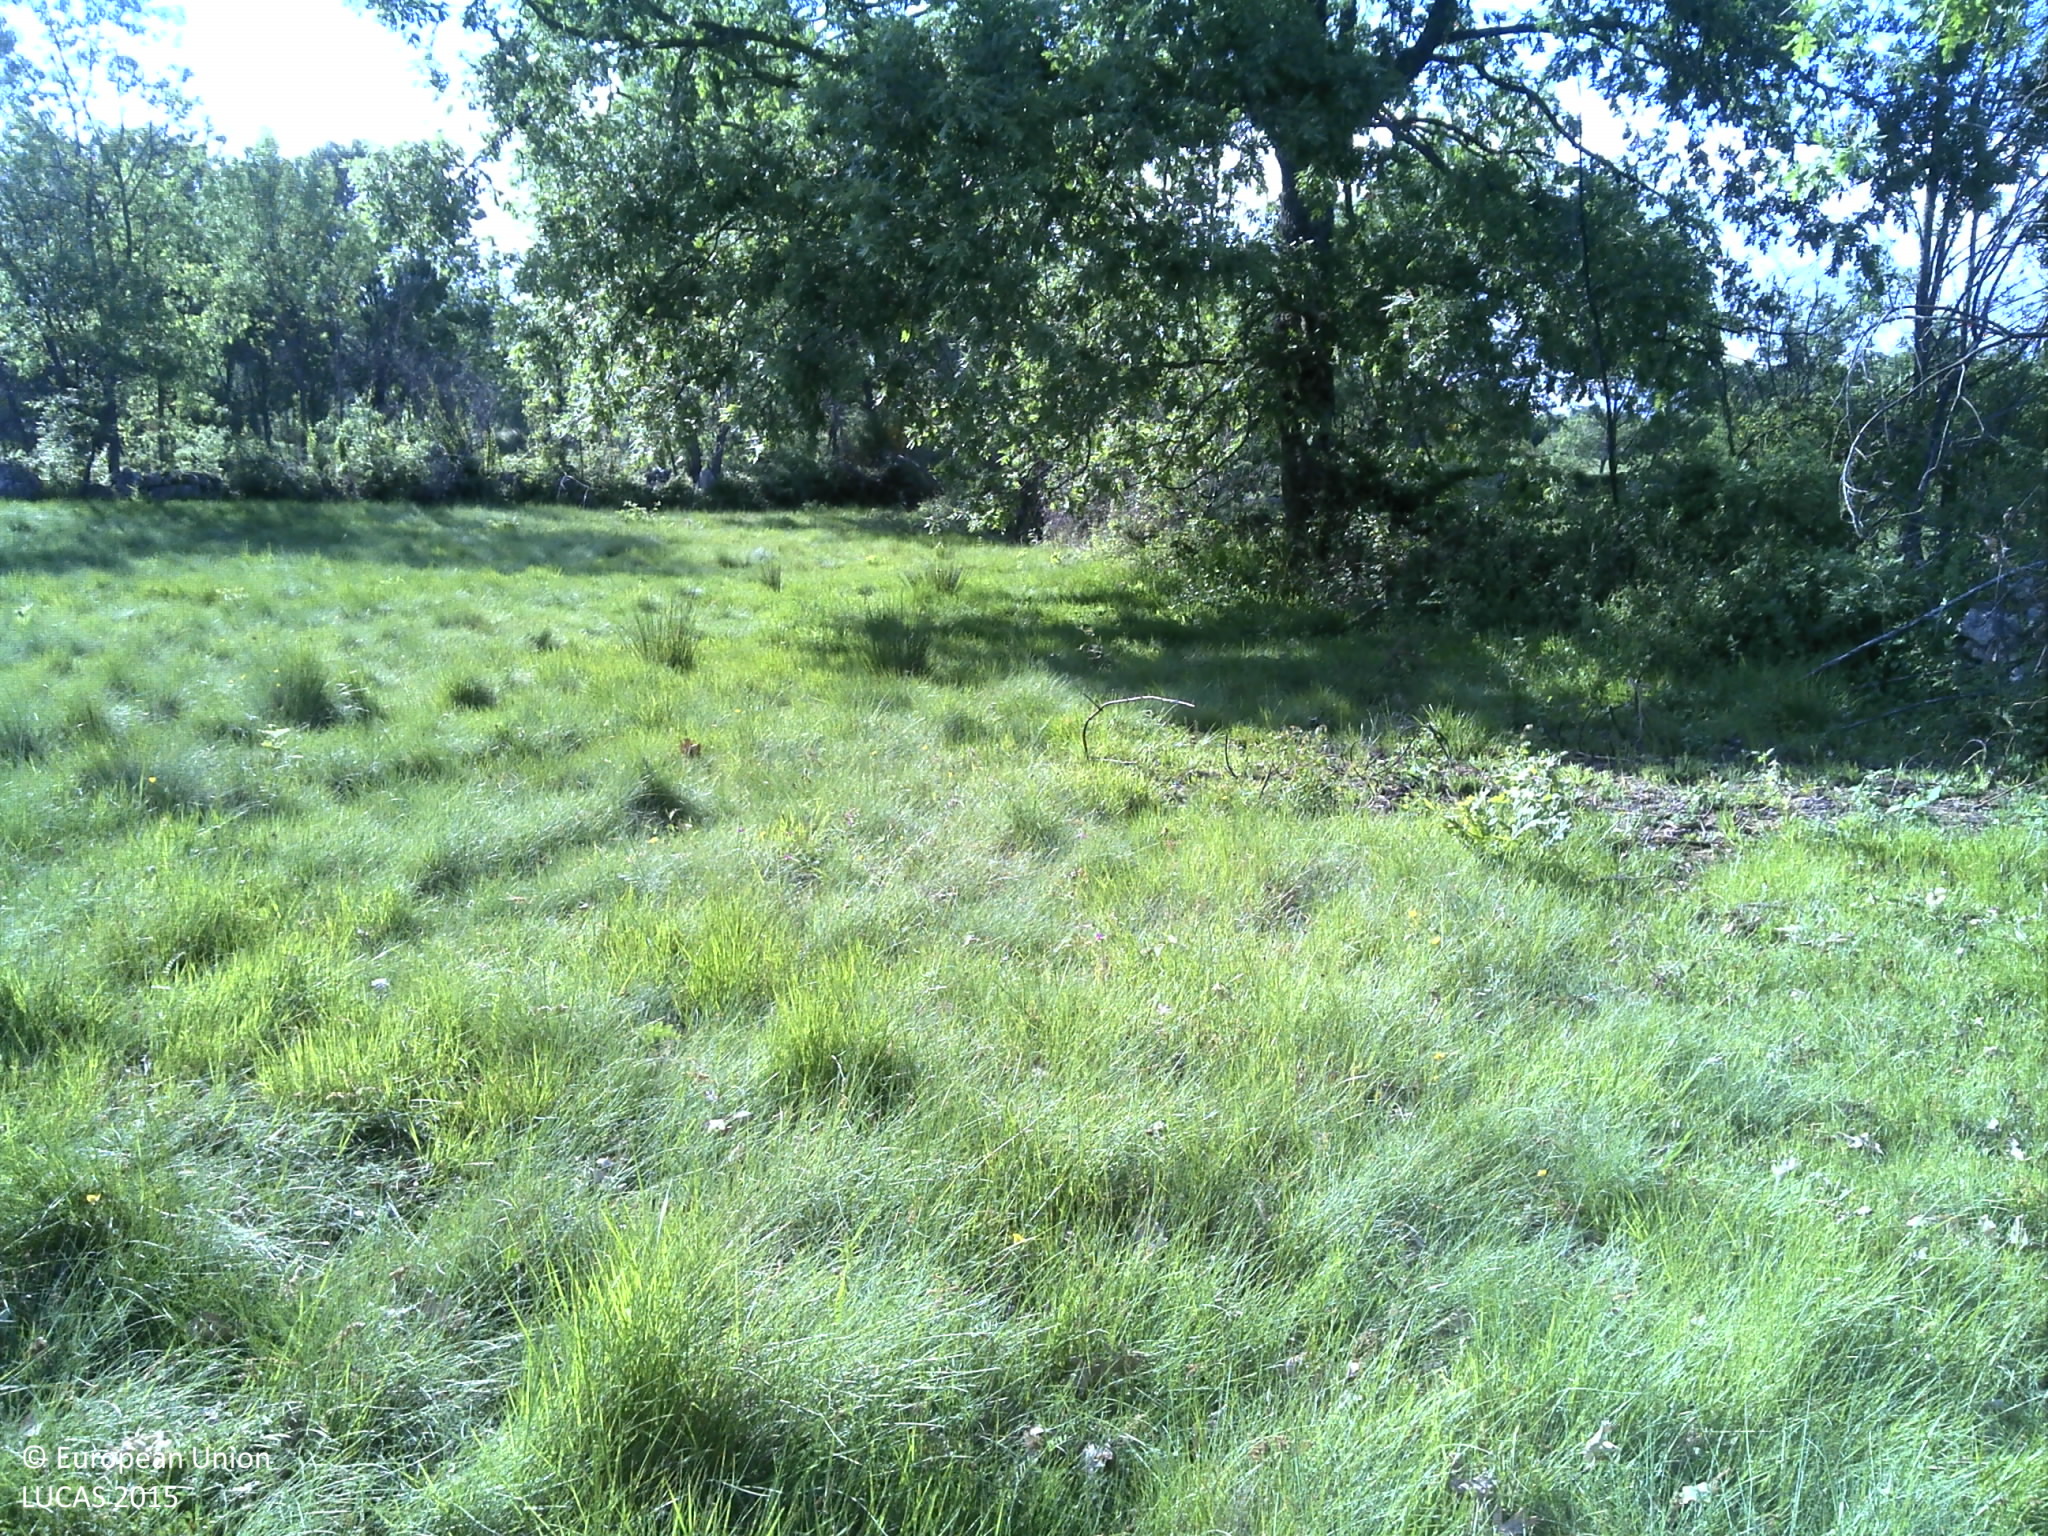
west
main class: Grassland
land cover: Grassland with sparse tree/shrub cover
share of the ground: > 75 %
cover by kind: herbaceous plants 95 %, broadleaved forest trees 5 %
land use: Agriculture (excluding fallow land and kitchen gardens)
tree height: > 5 m
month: May
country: PT
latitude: 41.6794
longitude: -7.3400
